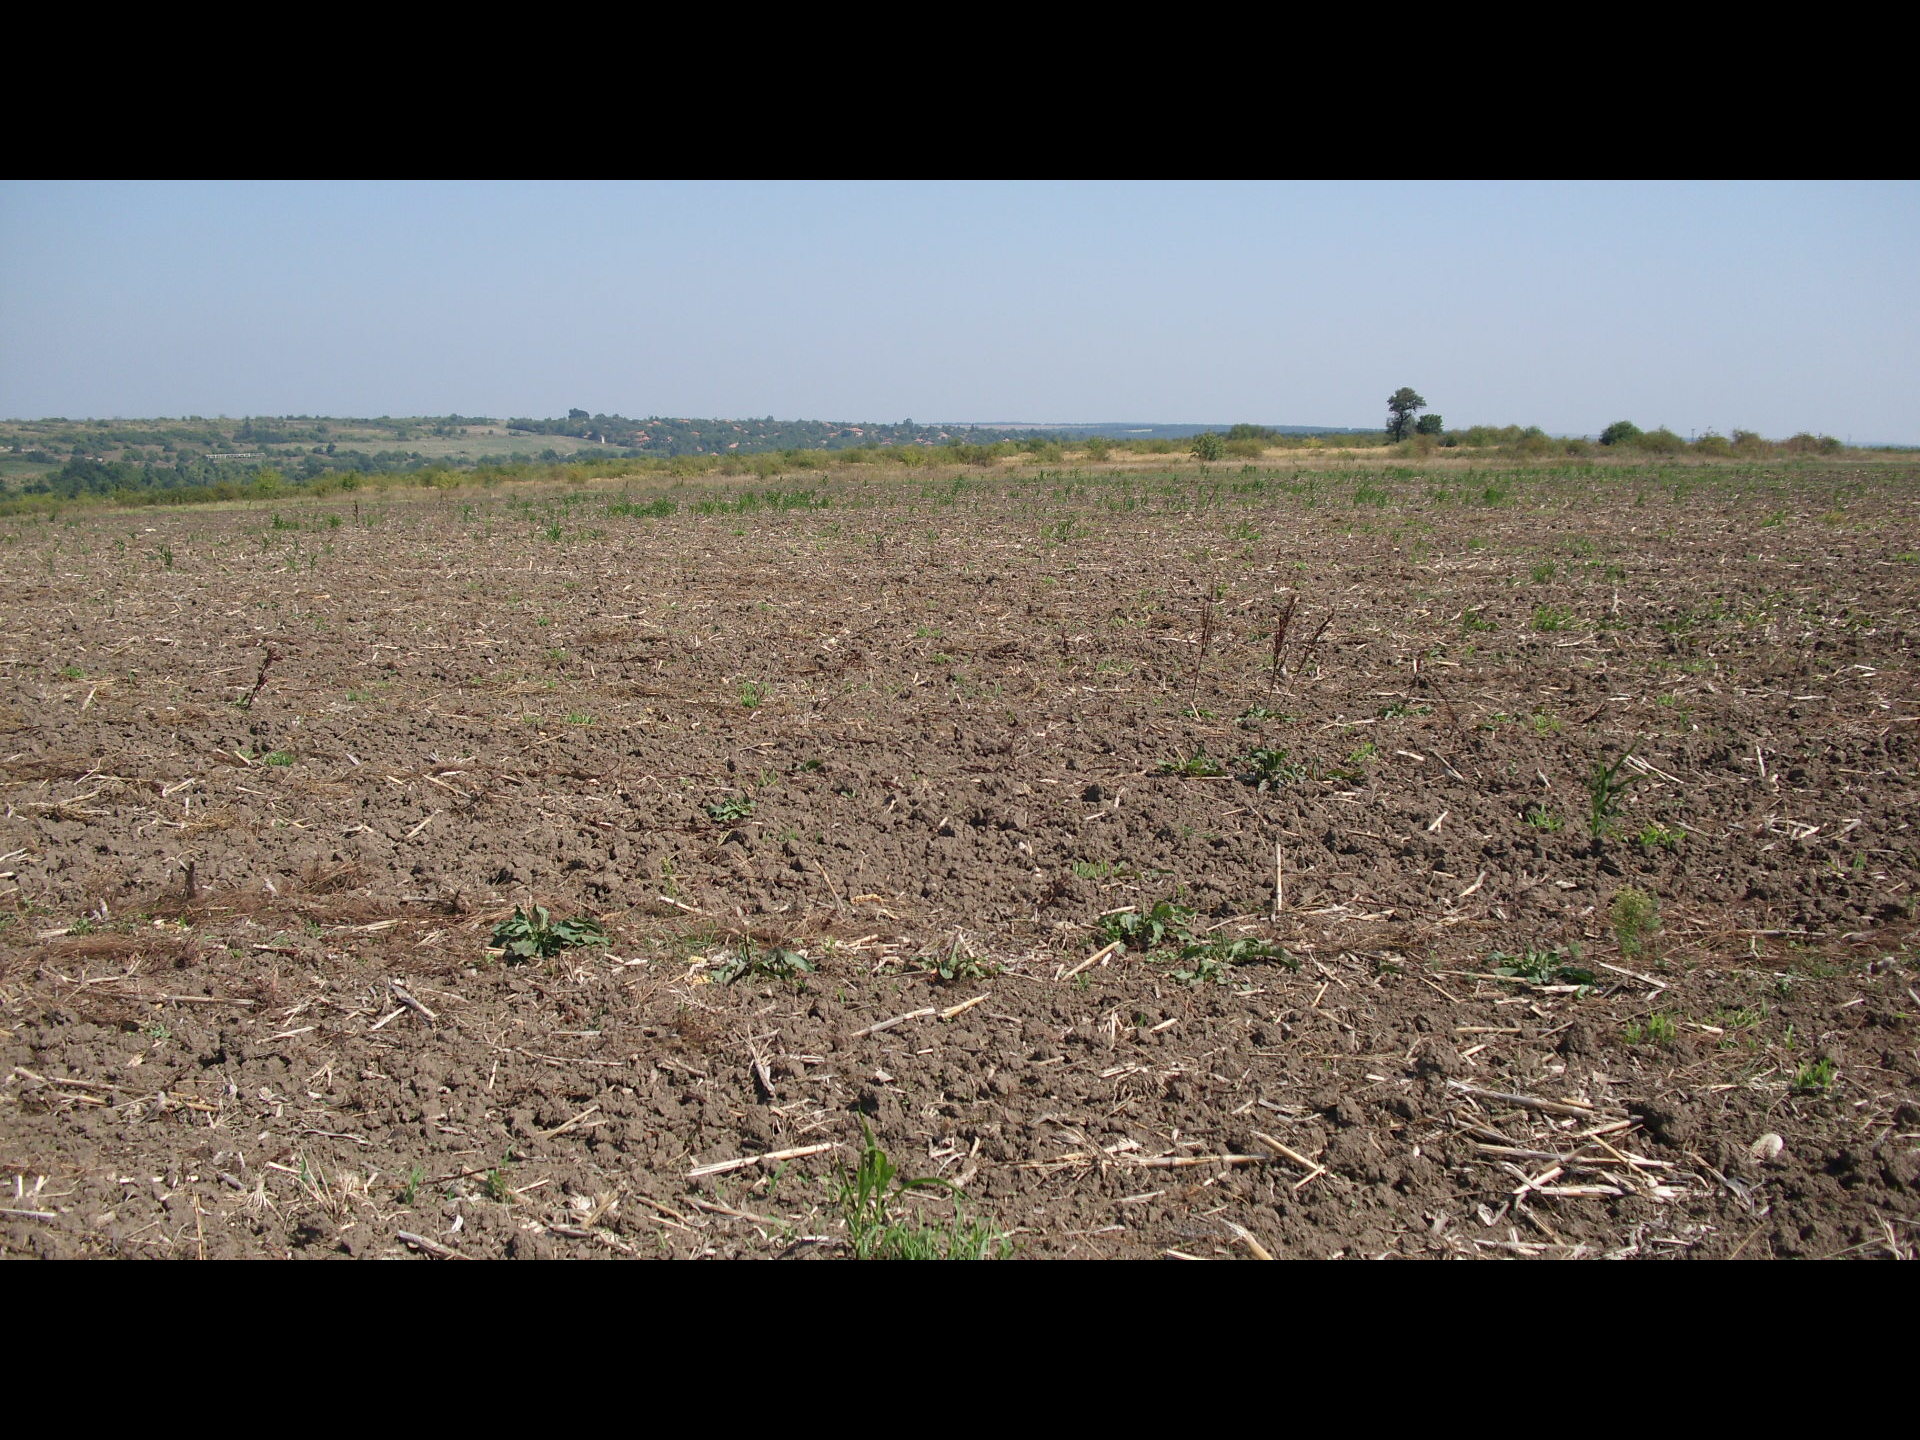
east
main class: Cropland
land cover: Maize
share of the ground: < 10 %
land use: Agriculture (excluding fallow land and kitchen gardens)
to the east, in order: Maize; Grass margins; Tracks; Grassland without tree/shrub cover; Tracks; Grassland with sparse tree/shrub cover
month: September
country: BG
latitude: 43.9906
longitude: 22.5160
